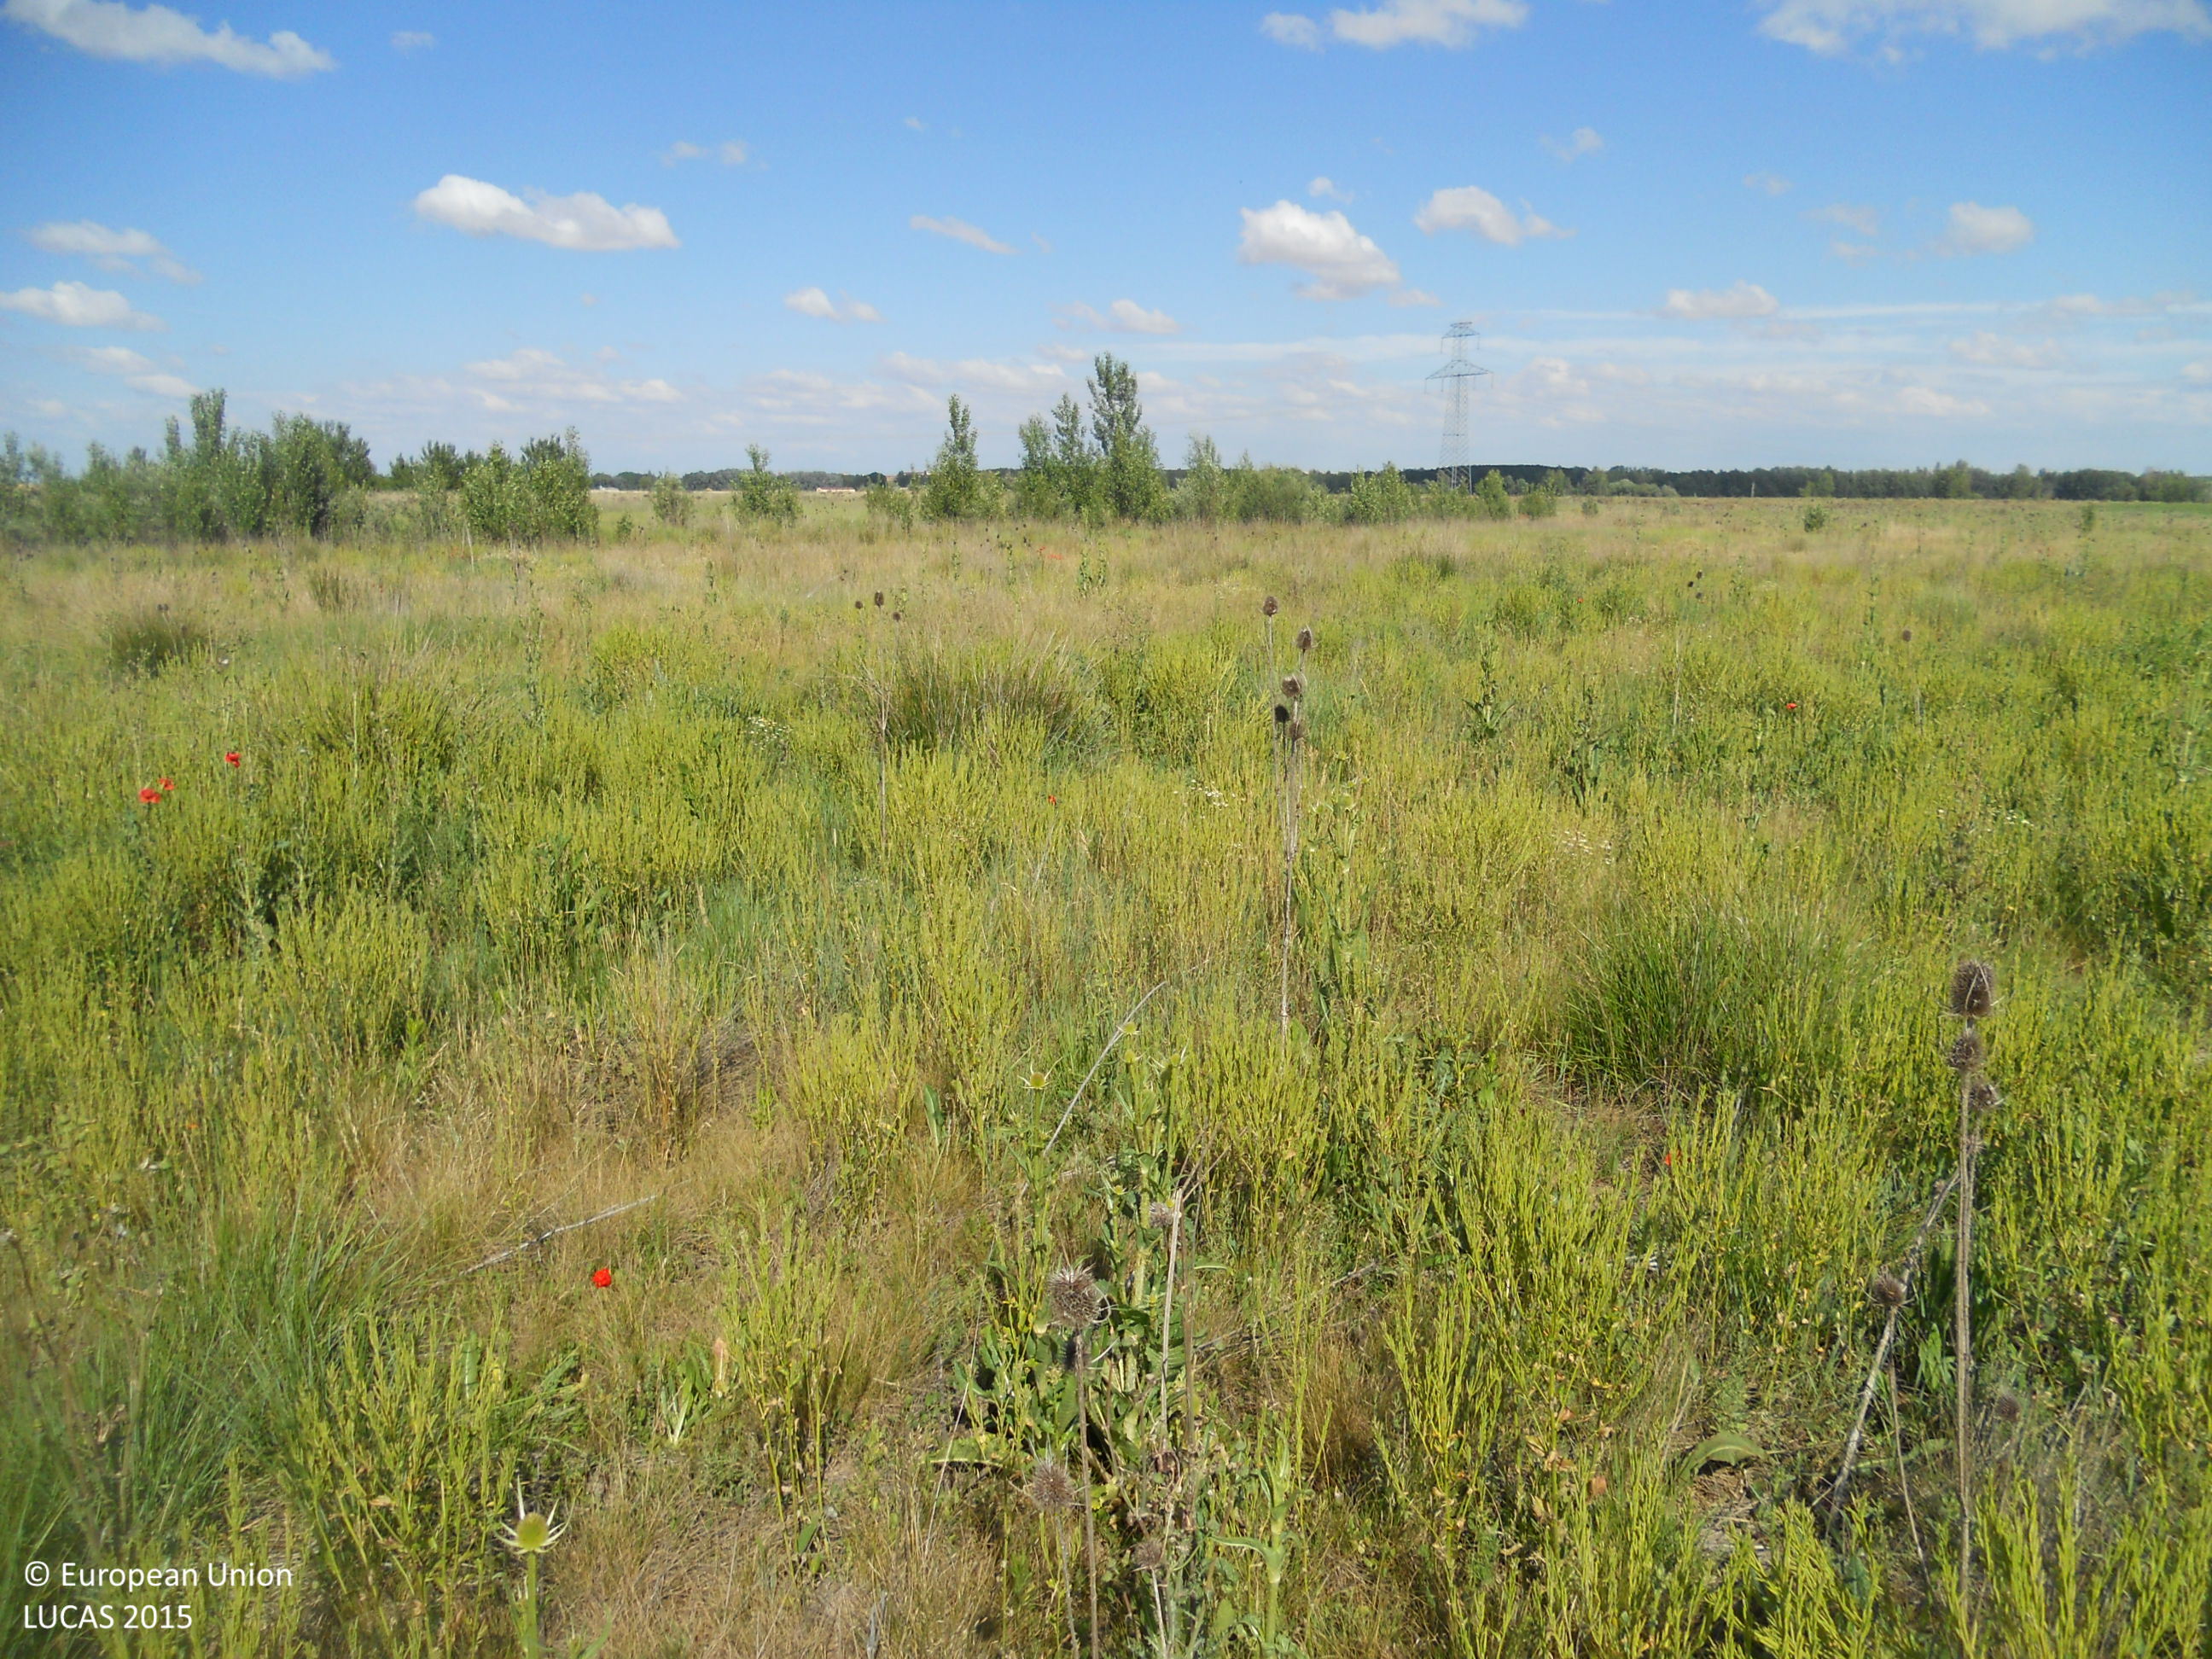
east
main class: Grassland
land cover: Grassland without tree/shrub cover
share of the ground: > 75 %
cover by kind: herbaceous plants 100 %
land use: Abandoned areas
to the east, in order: Grassland without tree/shrub cover; Grassland with sparse tree/shrub cover; Grassland without tree/shrub cover; Tracks; Grassland without tree/shrub cover
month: June
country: ES
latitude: 42.2087
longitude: -5.2383
